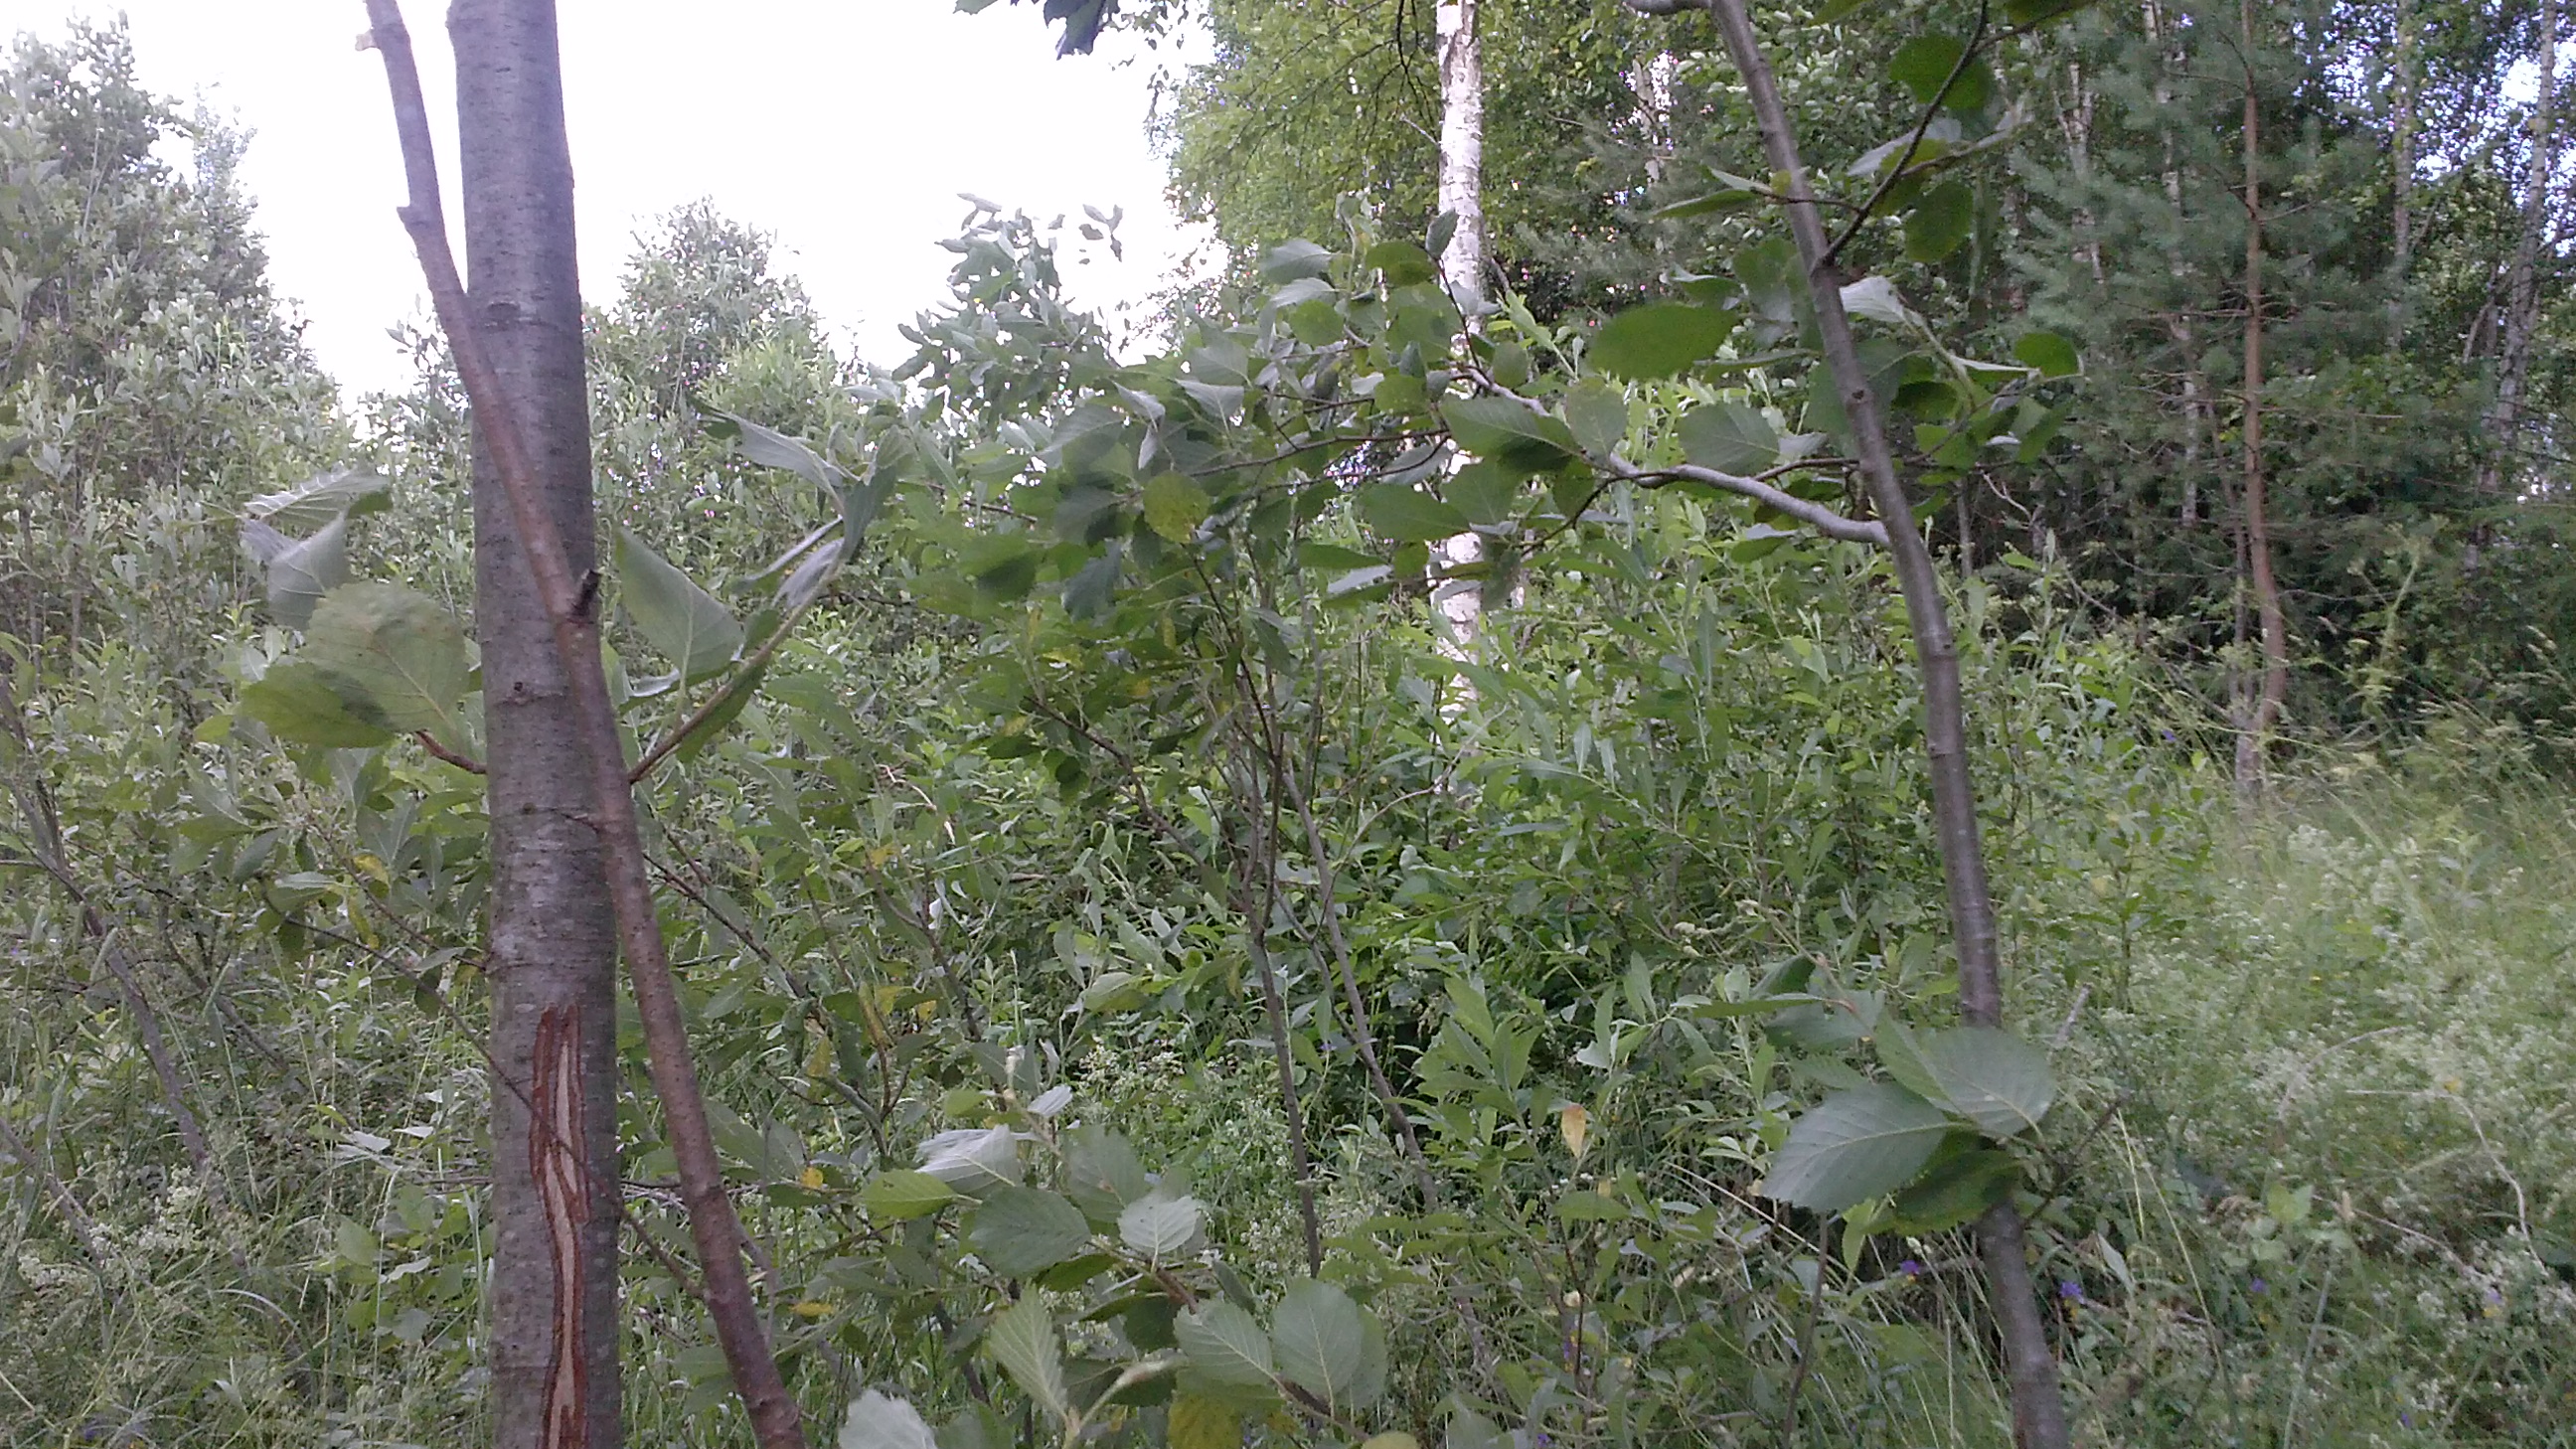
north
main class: Woodland
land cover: Broadleaved woodland
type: non-riverine alder, birch or aspen forest
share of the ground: 50 - 75 %
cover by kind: broadleaved forest trees 65 %, herbaceous plants 30 %, coniferous forest trees 5 %
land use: Forestry
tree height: > 5 m
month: July
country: LV
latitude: 56.5614
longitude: 27.4749
